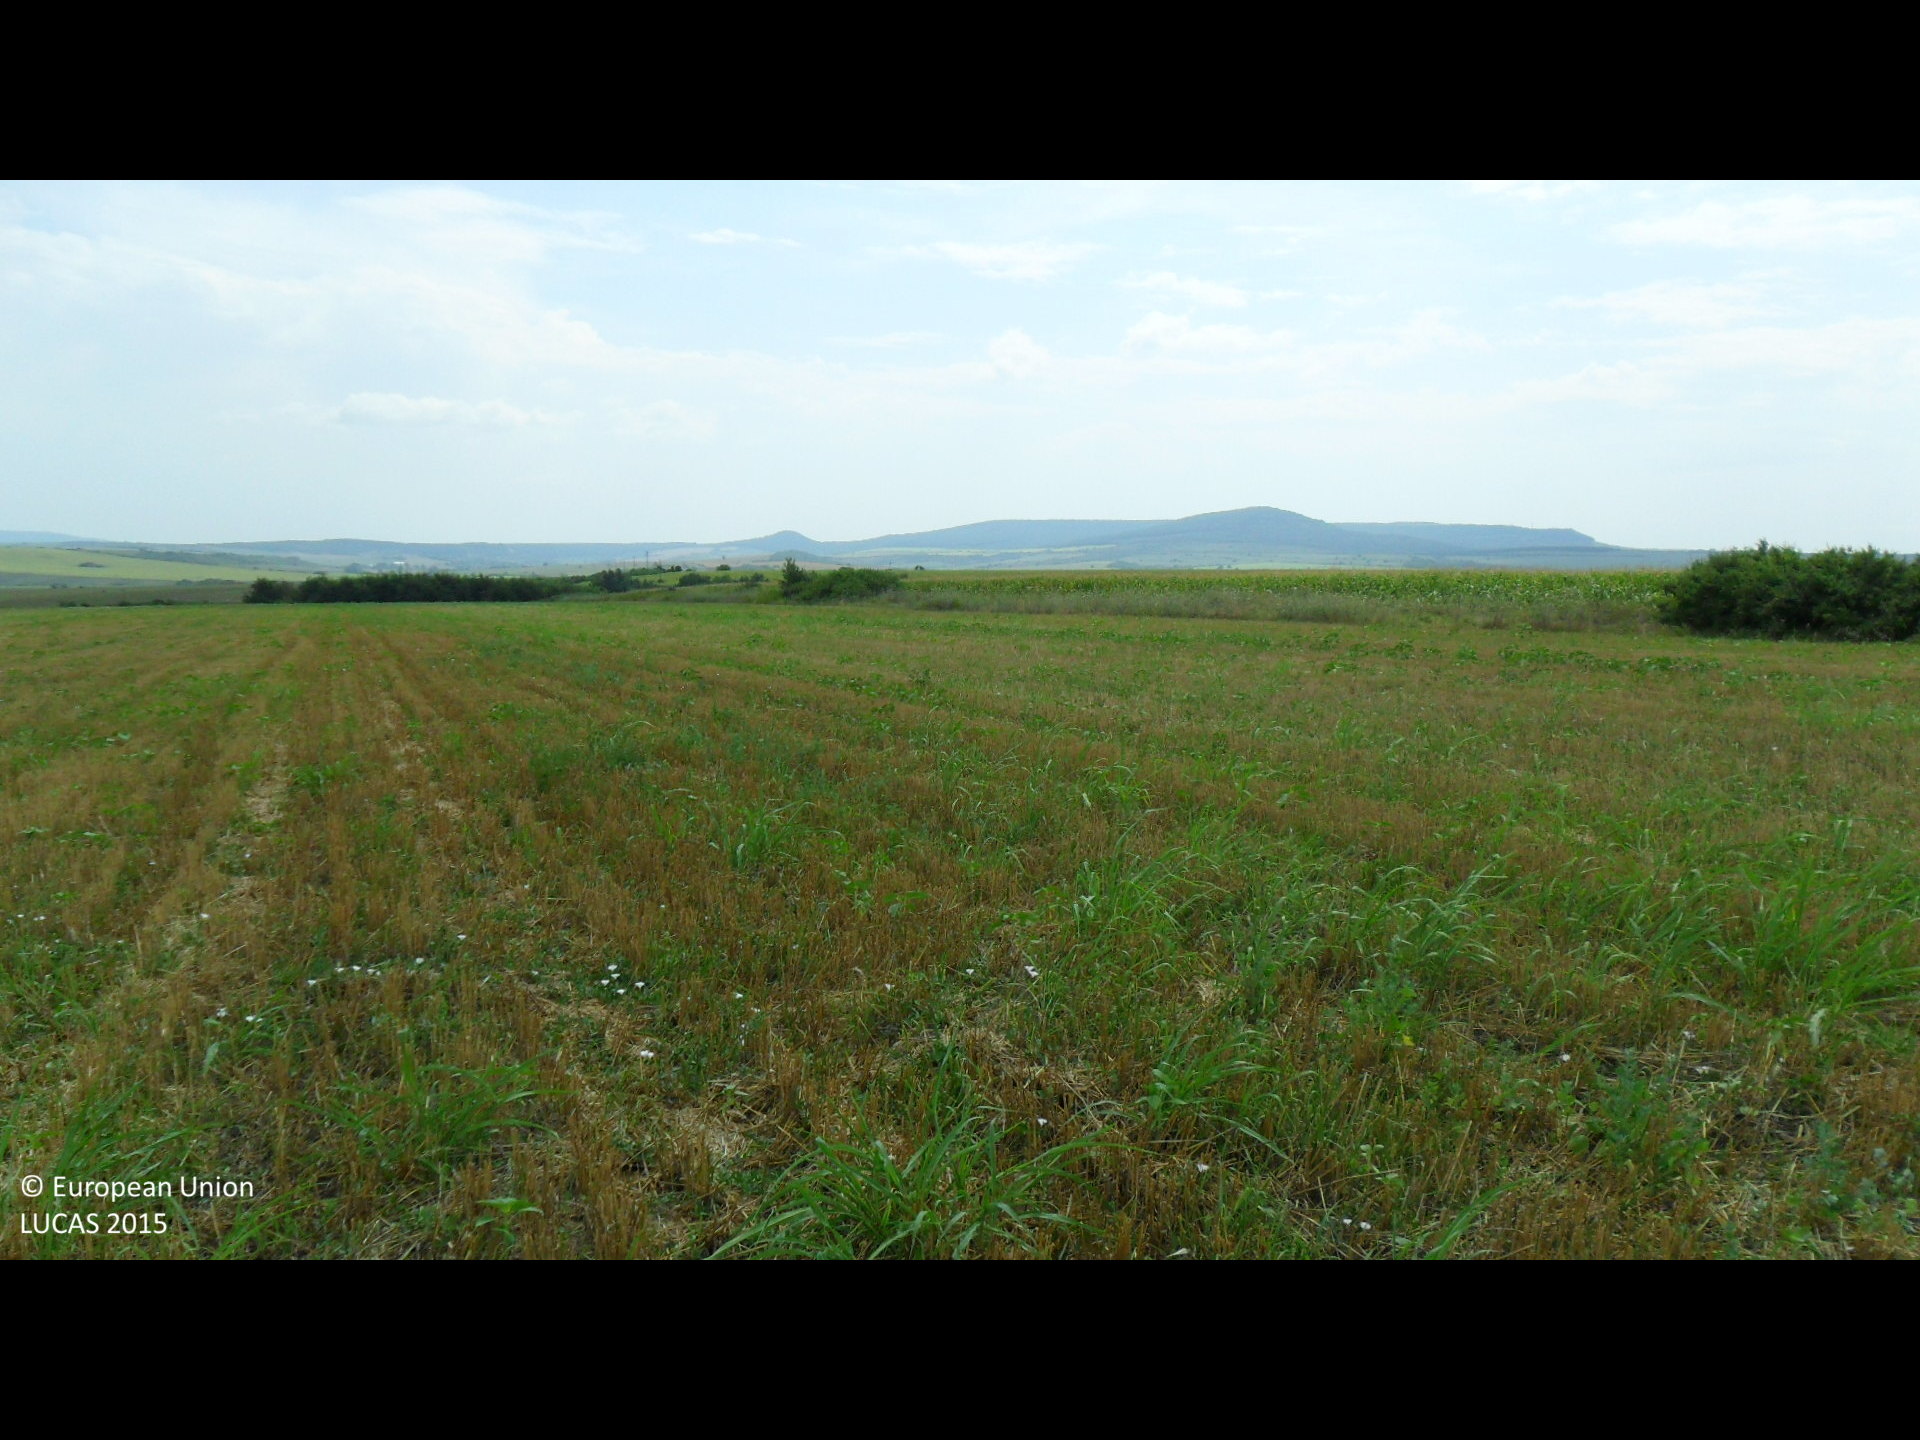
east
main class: Cropland
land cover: Barley
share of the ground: > 75 %
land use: Agriculture (excluding fallow land and kitchen gardens)
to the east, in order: Barley
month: August
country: BG
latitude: 43.3889
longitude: 26.2569
